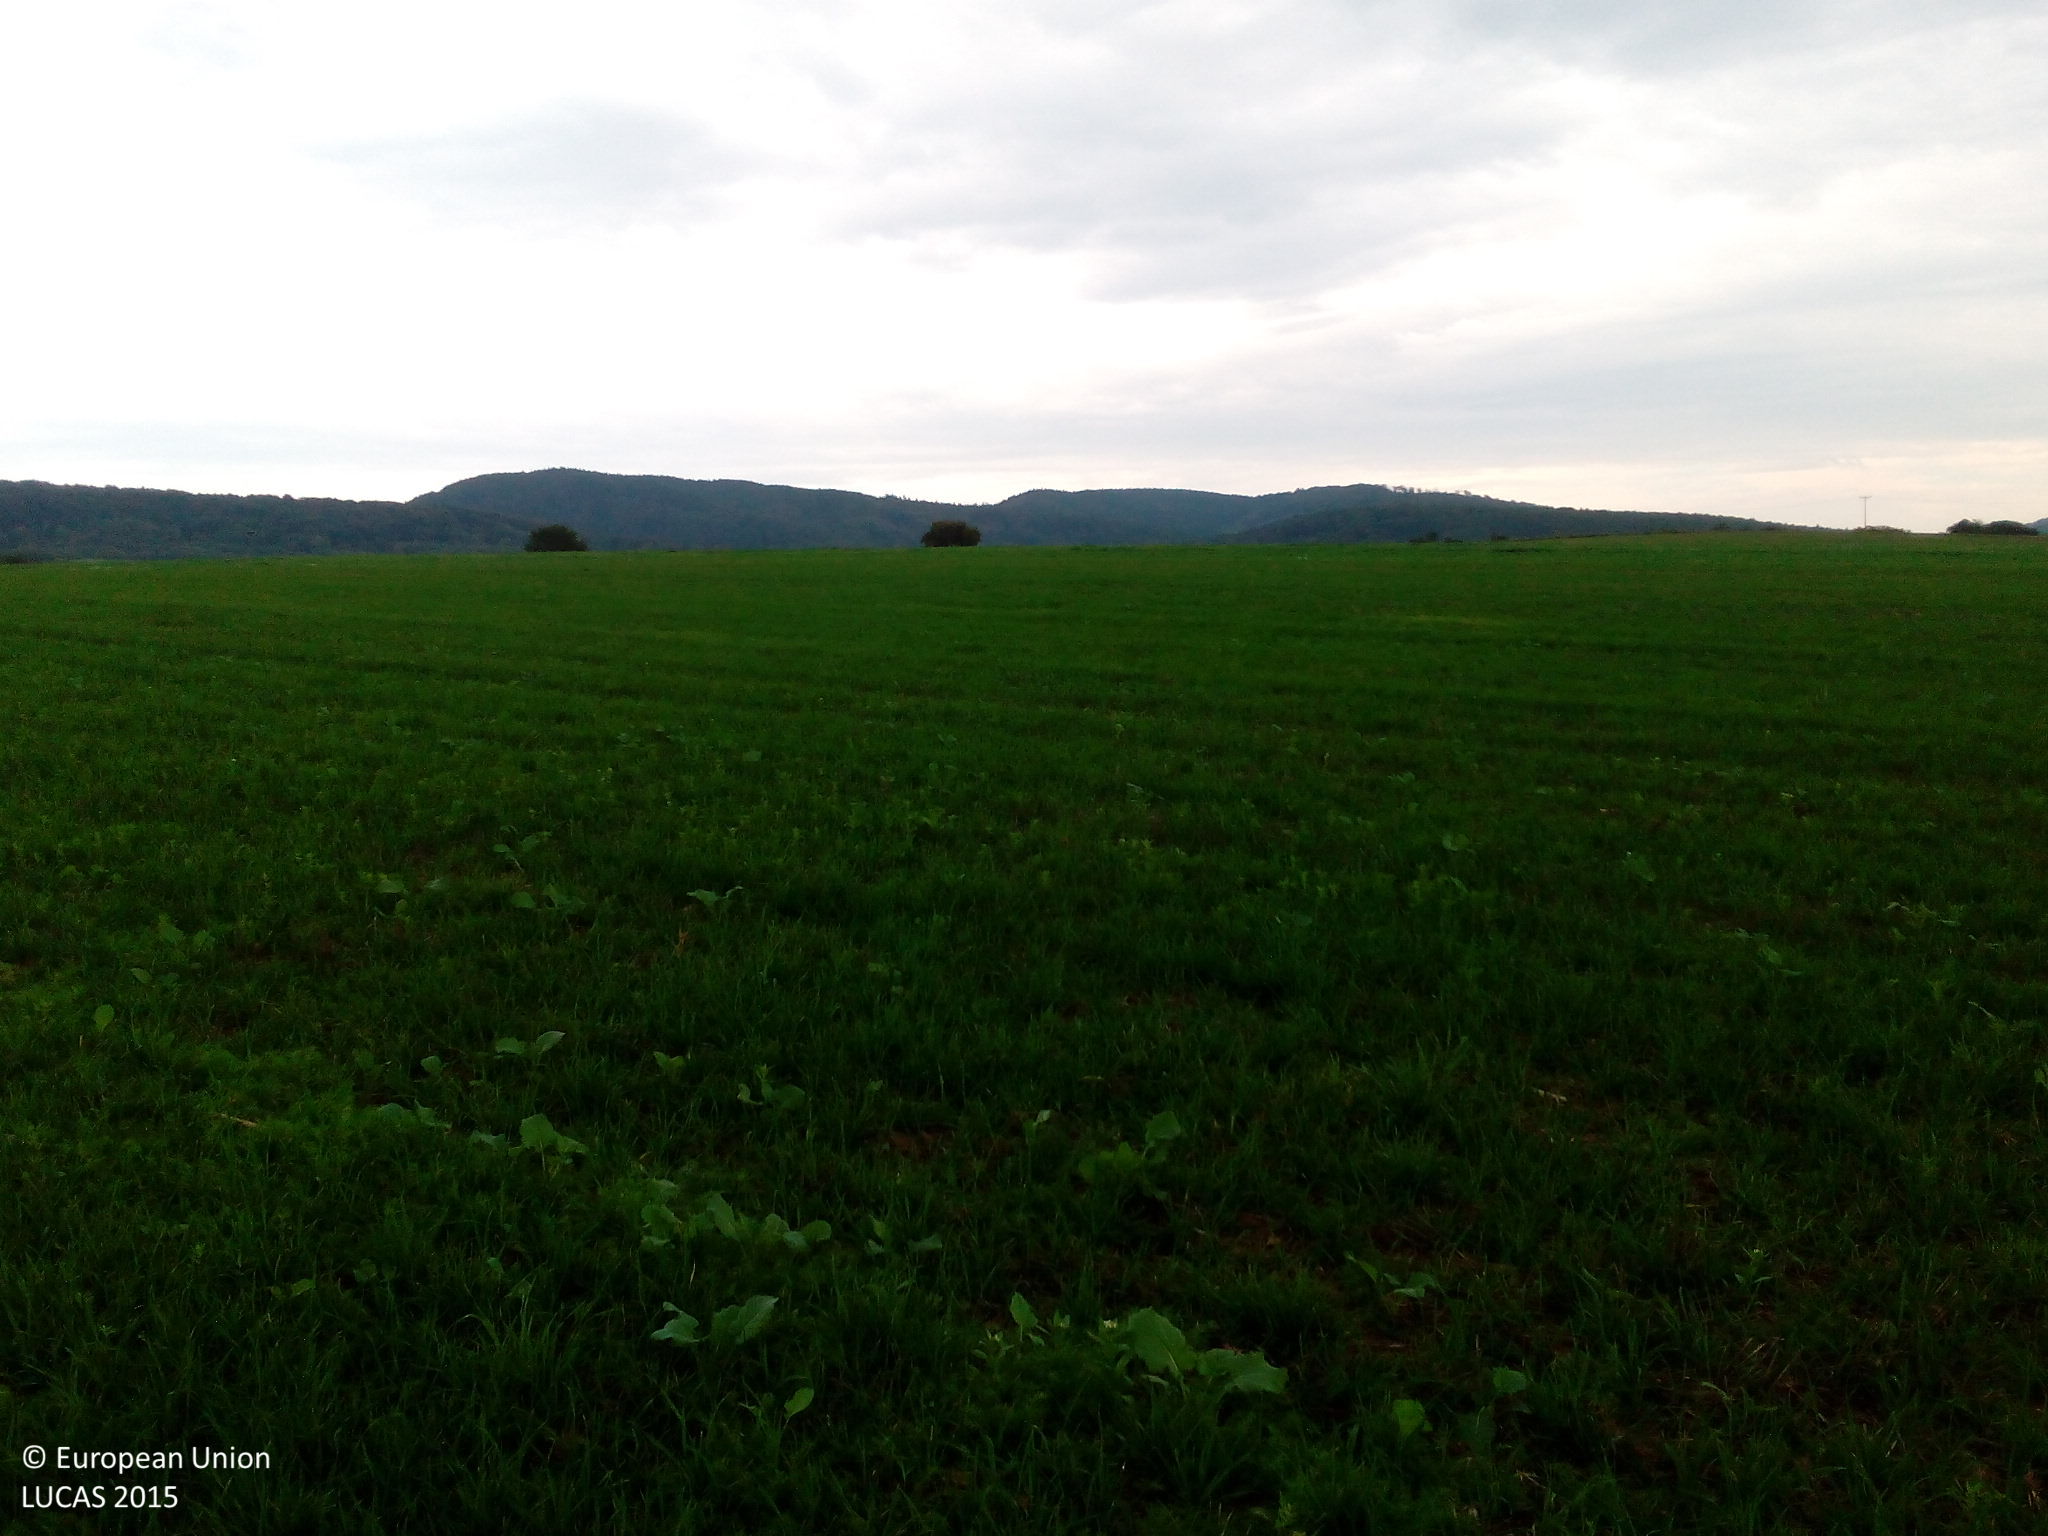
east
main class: Cropland
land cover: Common wheat
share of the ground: 50 - 75 %
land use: Agriculture (excluding fallow land and kitchen gardens)
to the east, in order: Common wheat; Rape and turnip rape
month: September
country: DE
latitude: 51.5107
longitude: 10.9651
